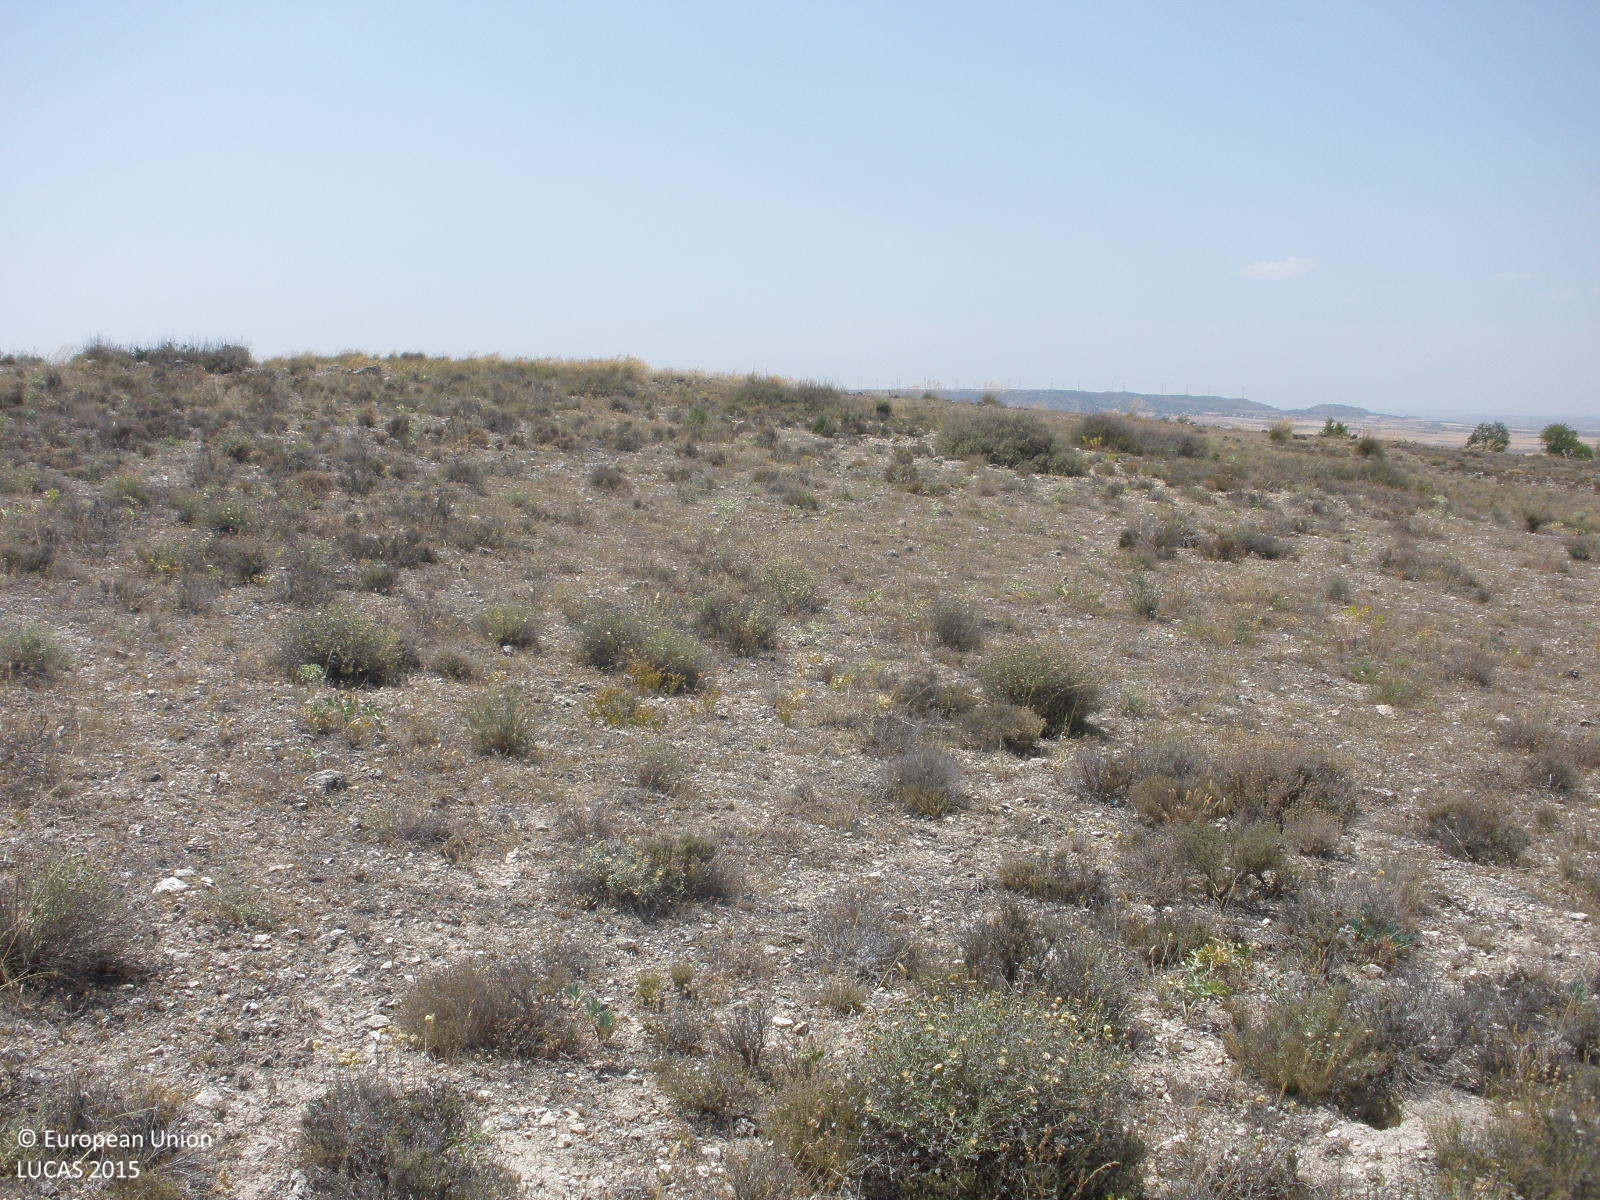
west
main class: Shrubland
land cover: Shrubland without tree cover
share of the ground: 50 - 75 %
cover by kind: shrubs 60 %, herbaceous plants 25 %, consolidated bare surface 15 %
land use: Semi-natural and natural areas not in use
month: July
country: ES
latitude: 39.9870
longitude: -3.2480
